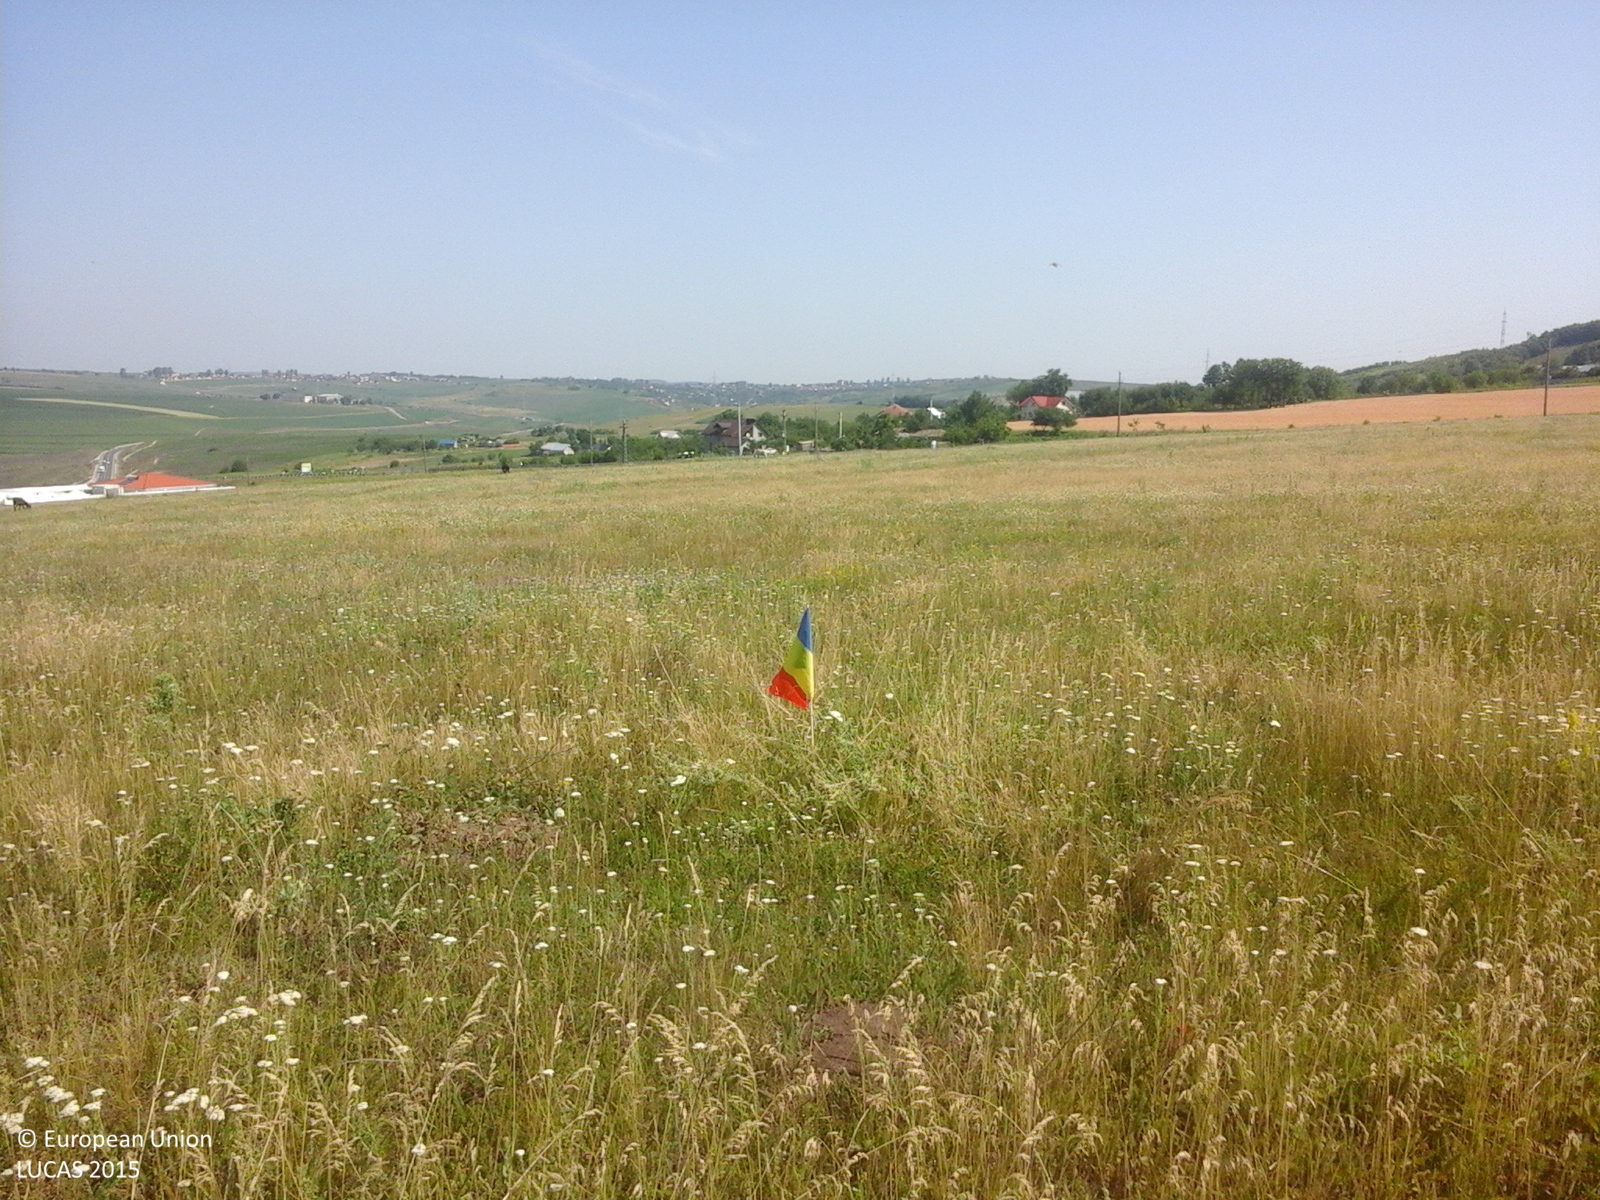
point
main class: Grassland
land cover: Grassland without tree/shrub cover
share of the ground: > 75 %
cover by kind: herbaceous plants 100 %
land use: Agriculture (excluding fallow land and kitchen gardens)
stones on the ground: < 10 %
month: June
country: RO
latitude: 47.1000
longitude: 27.5211
